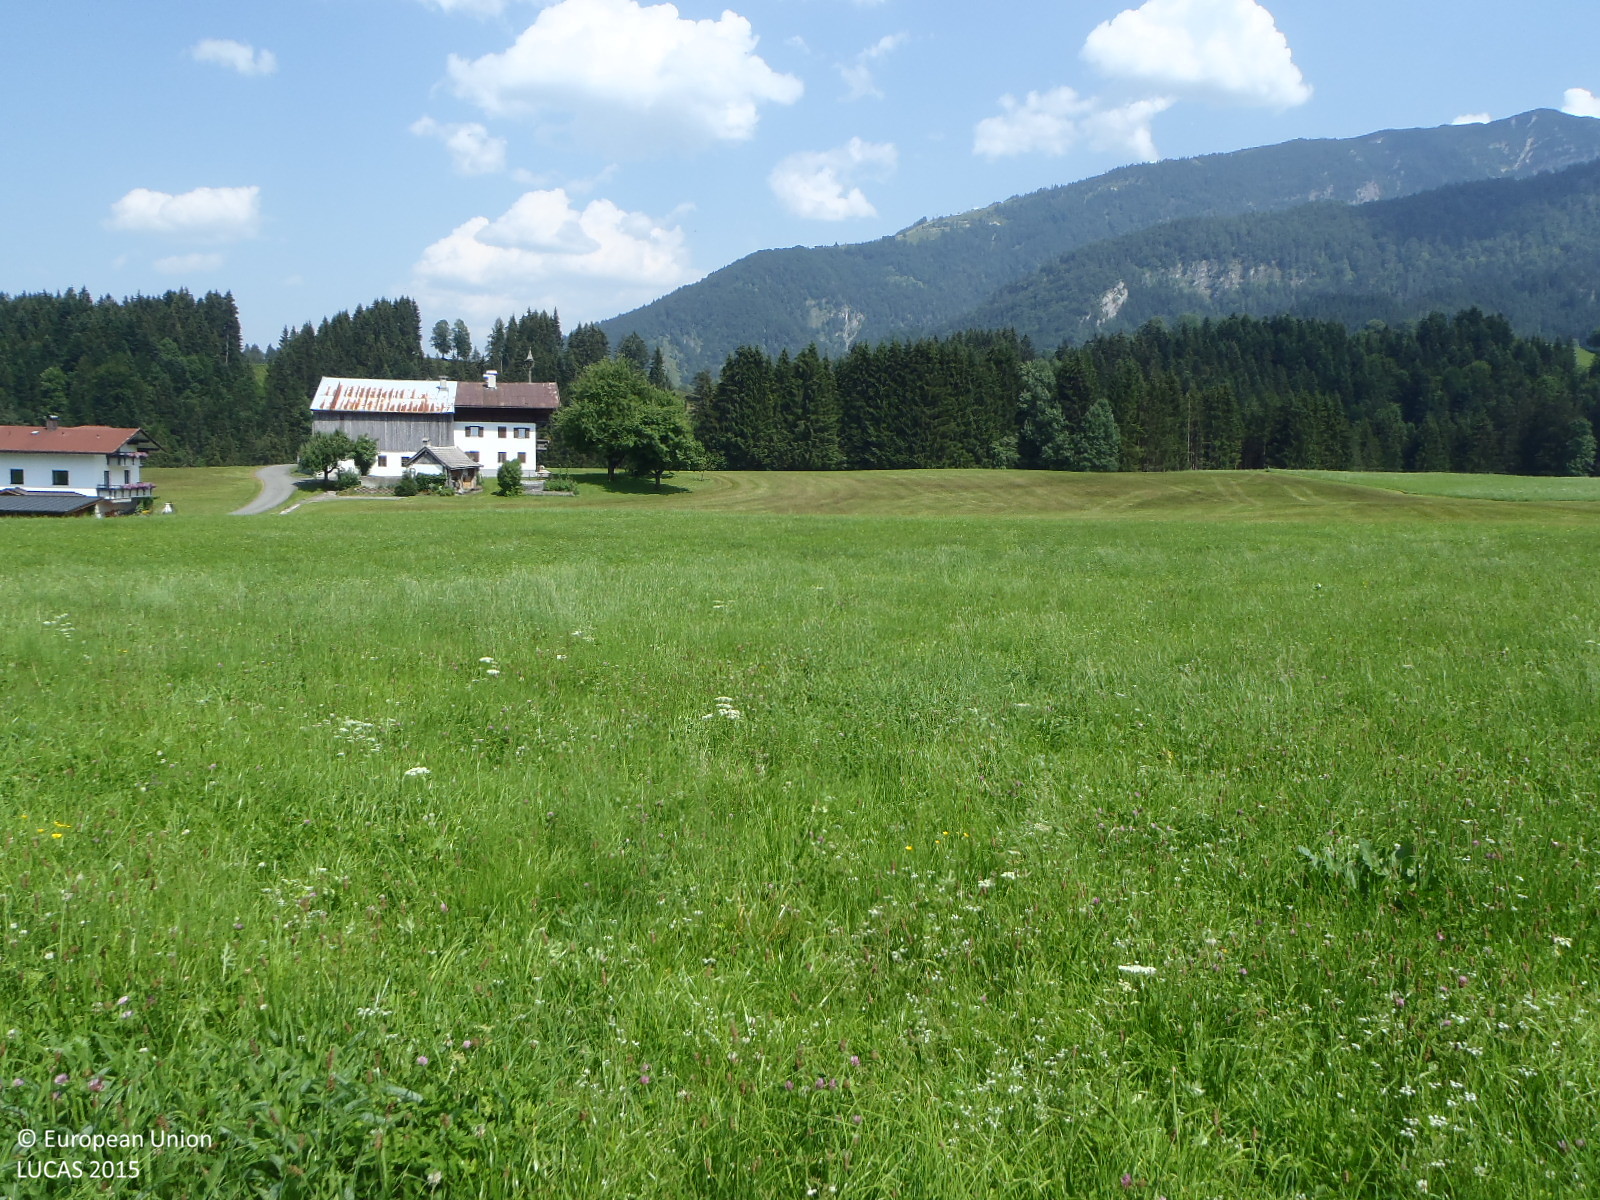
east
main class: Grassland
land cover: Grassland without tree/shrub cover
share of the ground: > 75 %
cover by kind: herbaceous plants 100 %
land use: Agriculture (excluding fallow land and kitchen gardens)
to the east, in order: Grassland without tree/shrub cover; Tracks; Grassland without tree/shrub cover; Spruce dominated coniferous woodland
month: July
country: AT
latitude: 47.6397
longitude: 12.3811
